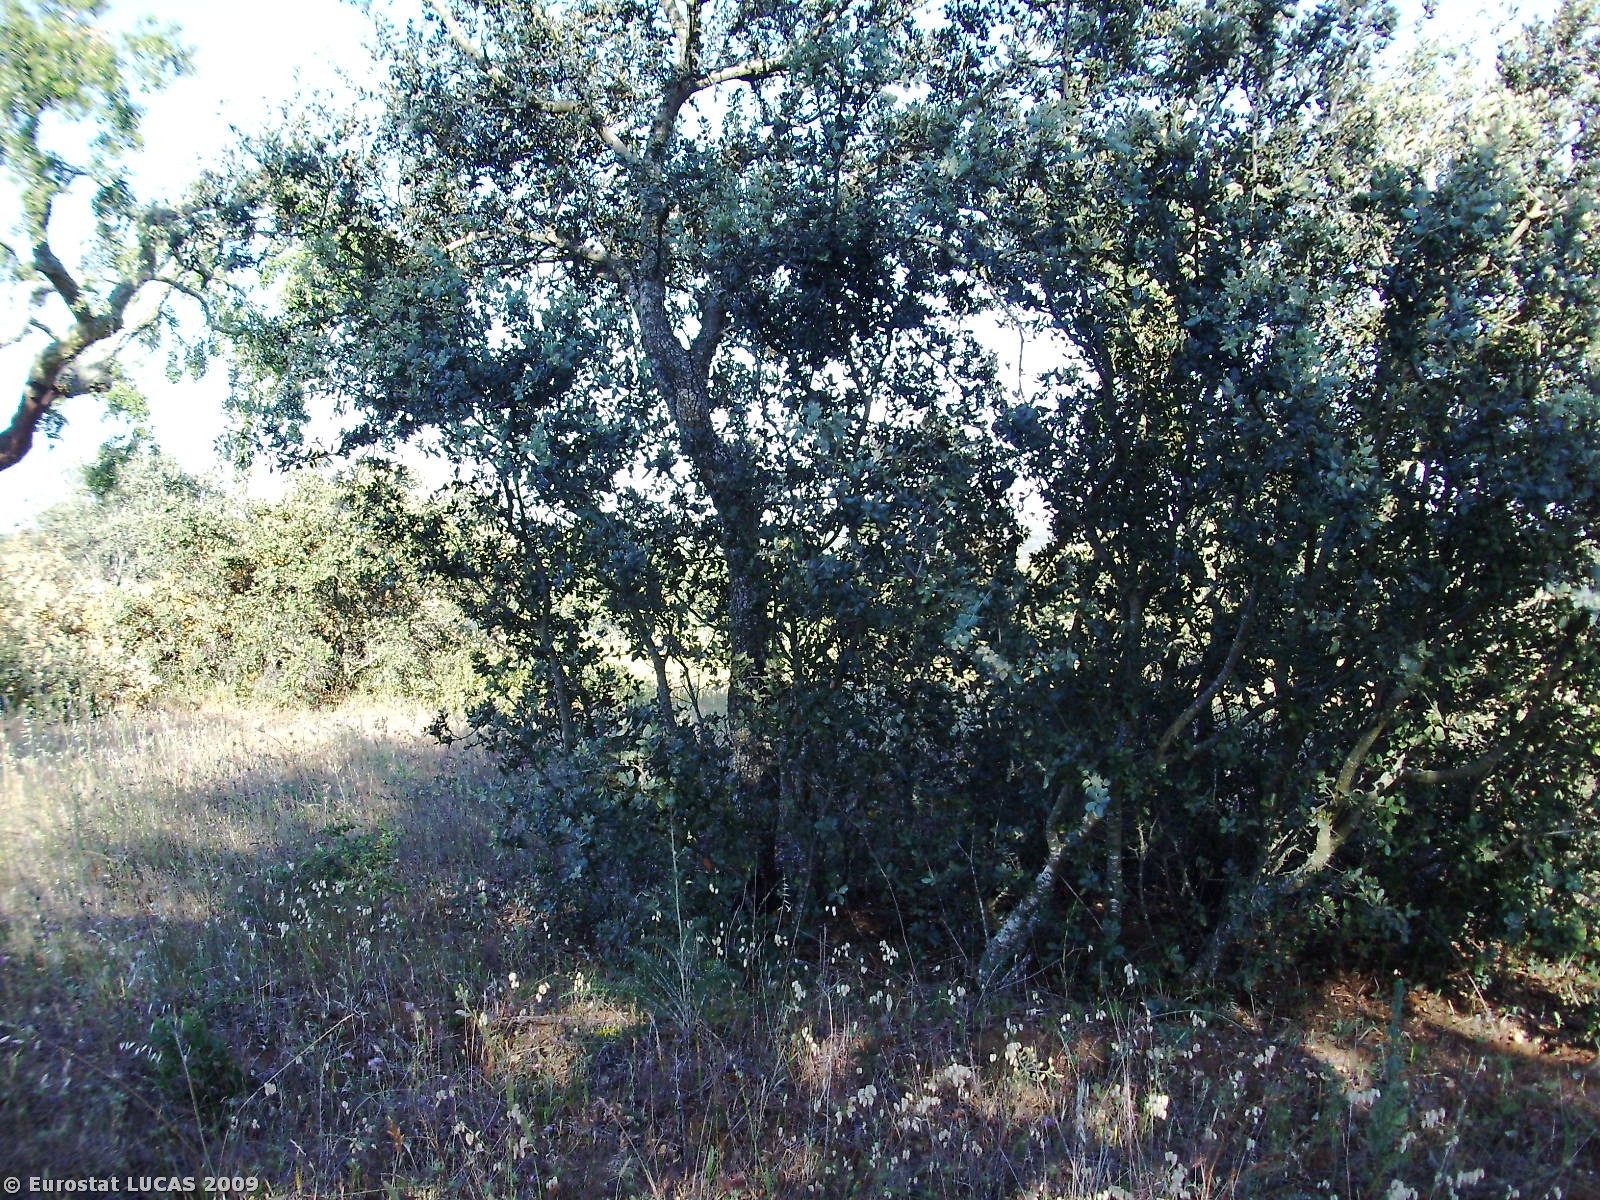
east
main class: Woodland
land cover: Broadleaved woodland
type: broadleaved evergreen forest
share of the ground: 25 - 50 %
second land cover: Spontaneously vegetated surfaces
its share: 50 - 75 %
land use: Forestry
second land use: Fallow land
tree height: > 5 m
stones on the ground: 10 - 25 %
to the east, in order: Broadleaved woodland; Spontaneously vegetated surfaces; Fences; Grassland with sparse tree/shrub cover; Lines of trees; Spontaneously vegetated surfaces; Fences; Paved roads, cycling and walking lanes; Fences; Single bushes/trees; Spontaneously vegetated surfaces
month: May
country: PT
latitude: 38.9870
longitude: -7.3391
